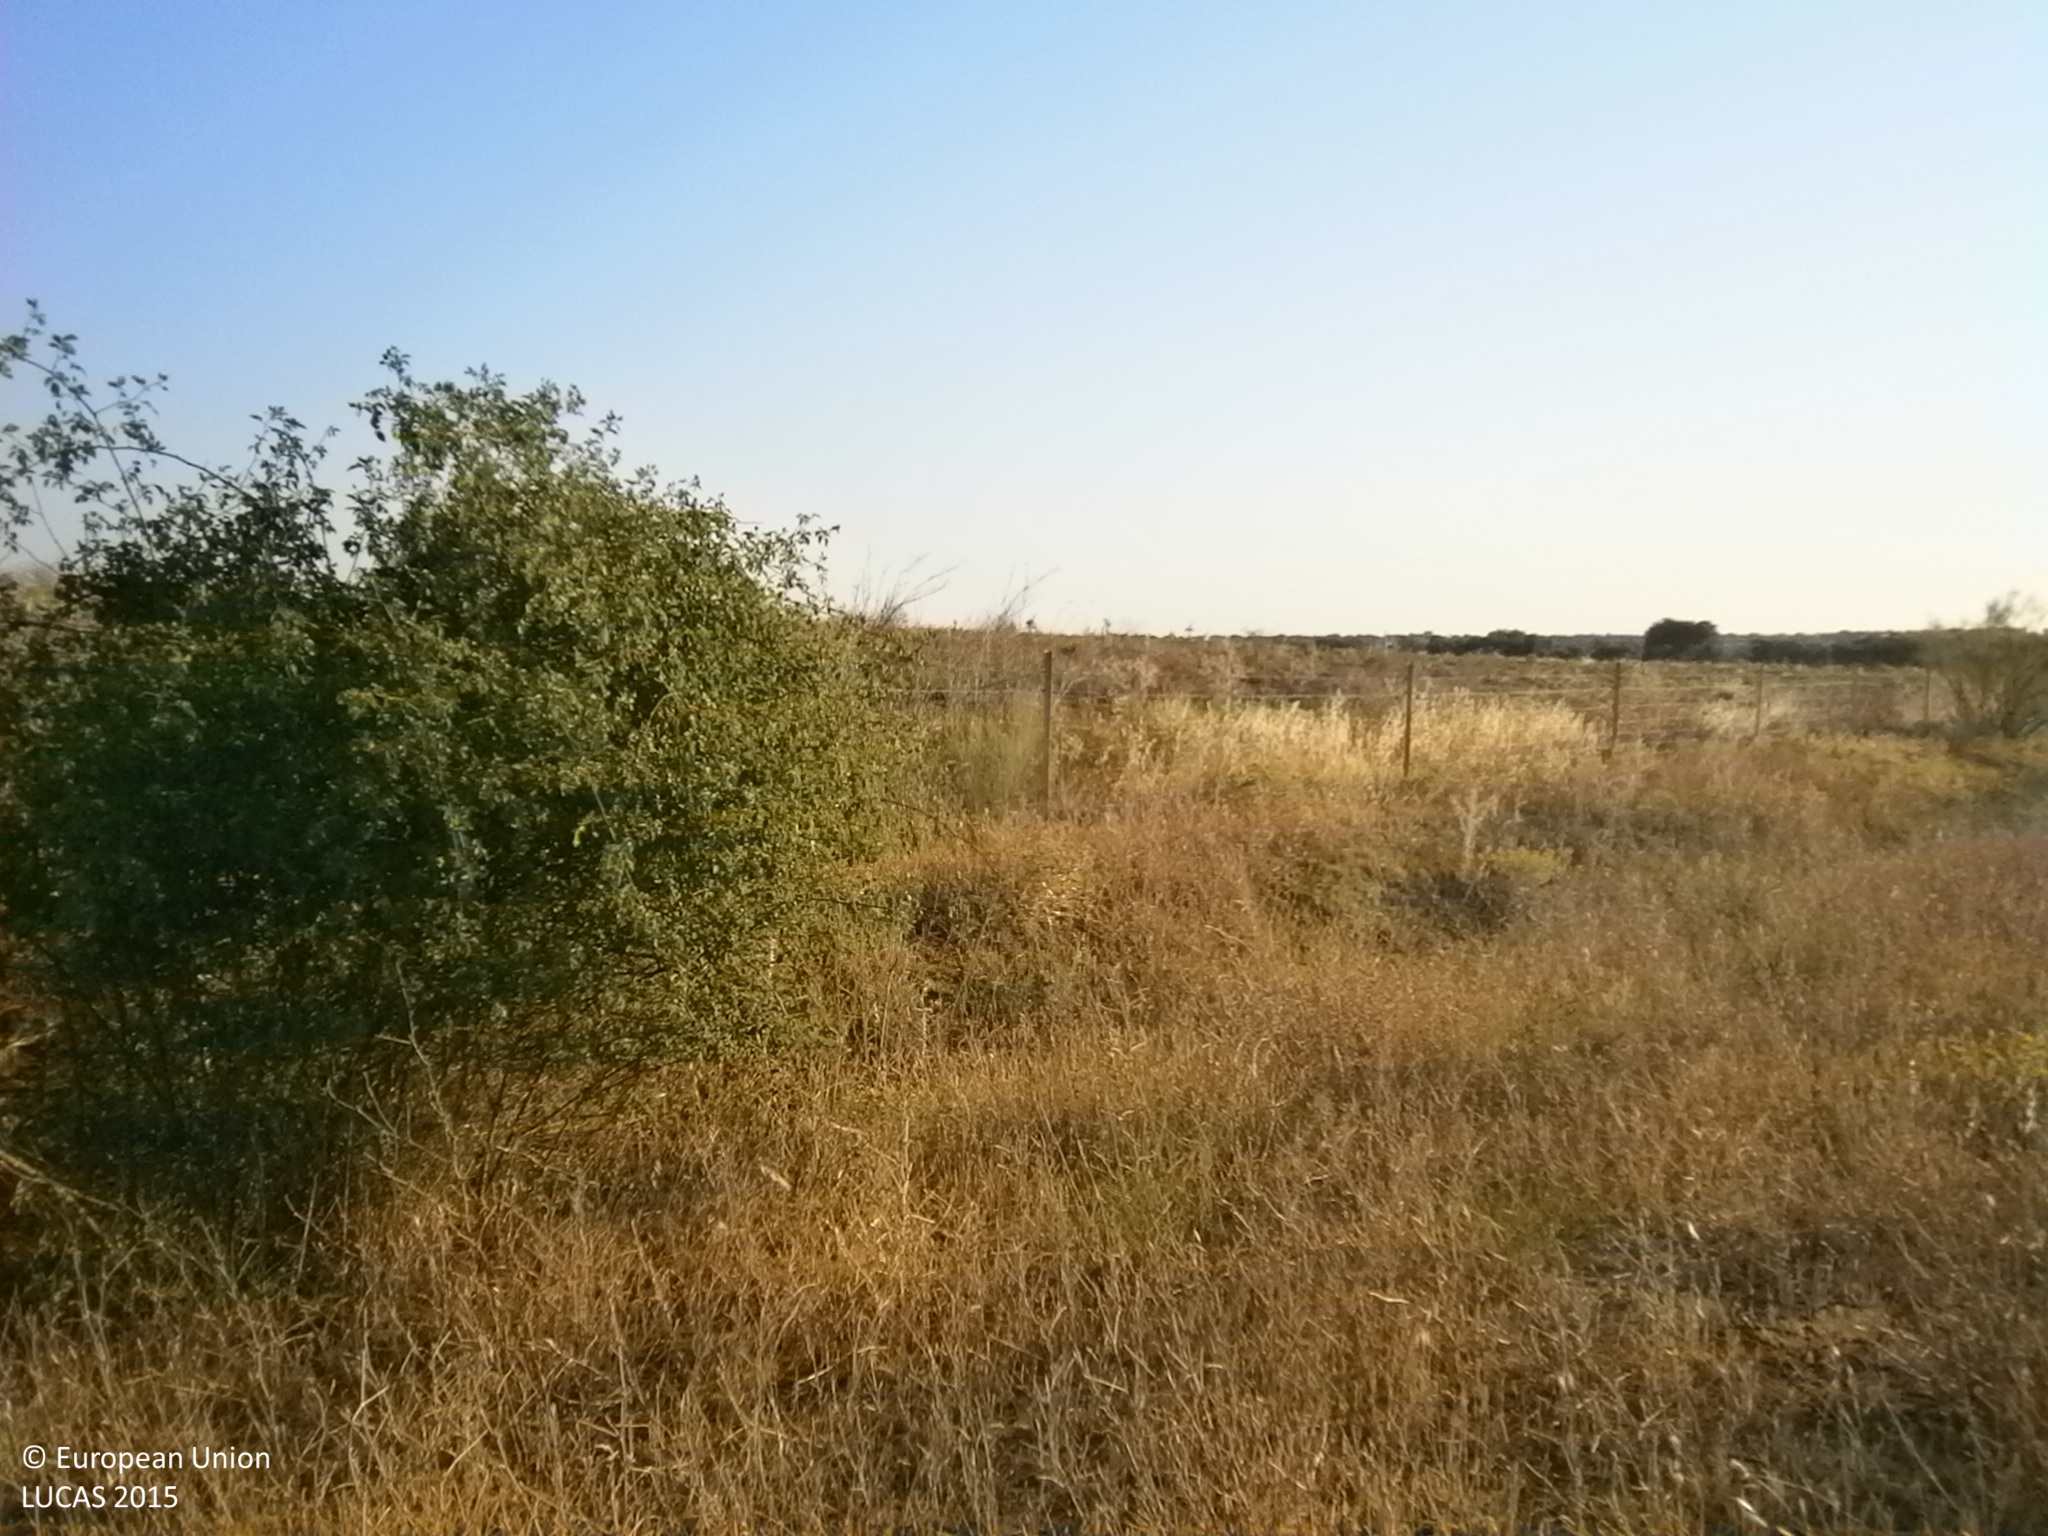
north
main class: Grassland
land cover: Spontaneously vegetated surfaces
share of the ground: > 75 %
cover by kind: herbaceous plants 95 %, unconsolidated bare surface 5 %
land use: Abandoned areas
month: June
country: ES
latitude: 38.6447
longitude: -6.7786
